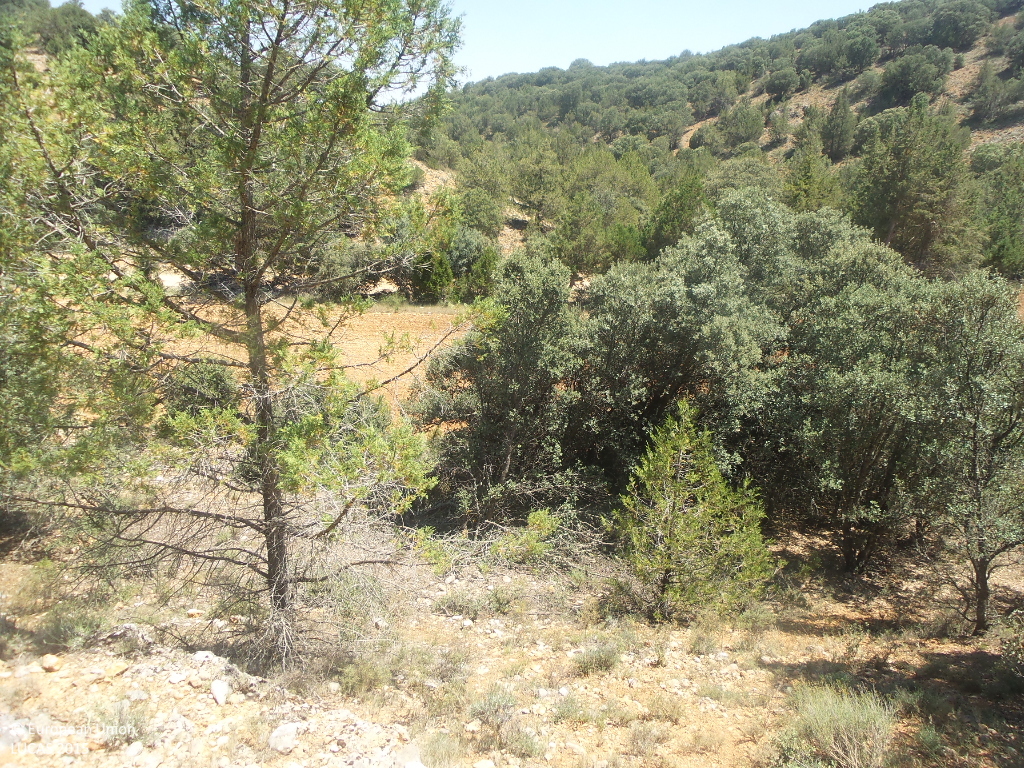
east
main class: Woodland
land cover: Other mixed woodland
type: broadleaved evergreen forest
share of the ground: 50 - 75 %
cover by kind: broadleaved forest trees 40 %, coniferous forest trees 20 %, shrubs 15 %, unconsolidated bare surface 15 %, herbaceous plants 5 %, consolidated bare surface 5 %
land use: Semi-natural and natural areas not in use
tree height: > 5 m
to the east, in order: Other mixed woodland; Other bare soil; Lines of trees; Tracks; Other mixed woodland
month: July
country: ES
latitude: 41.1323
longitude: -2.0223
